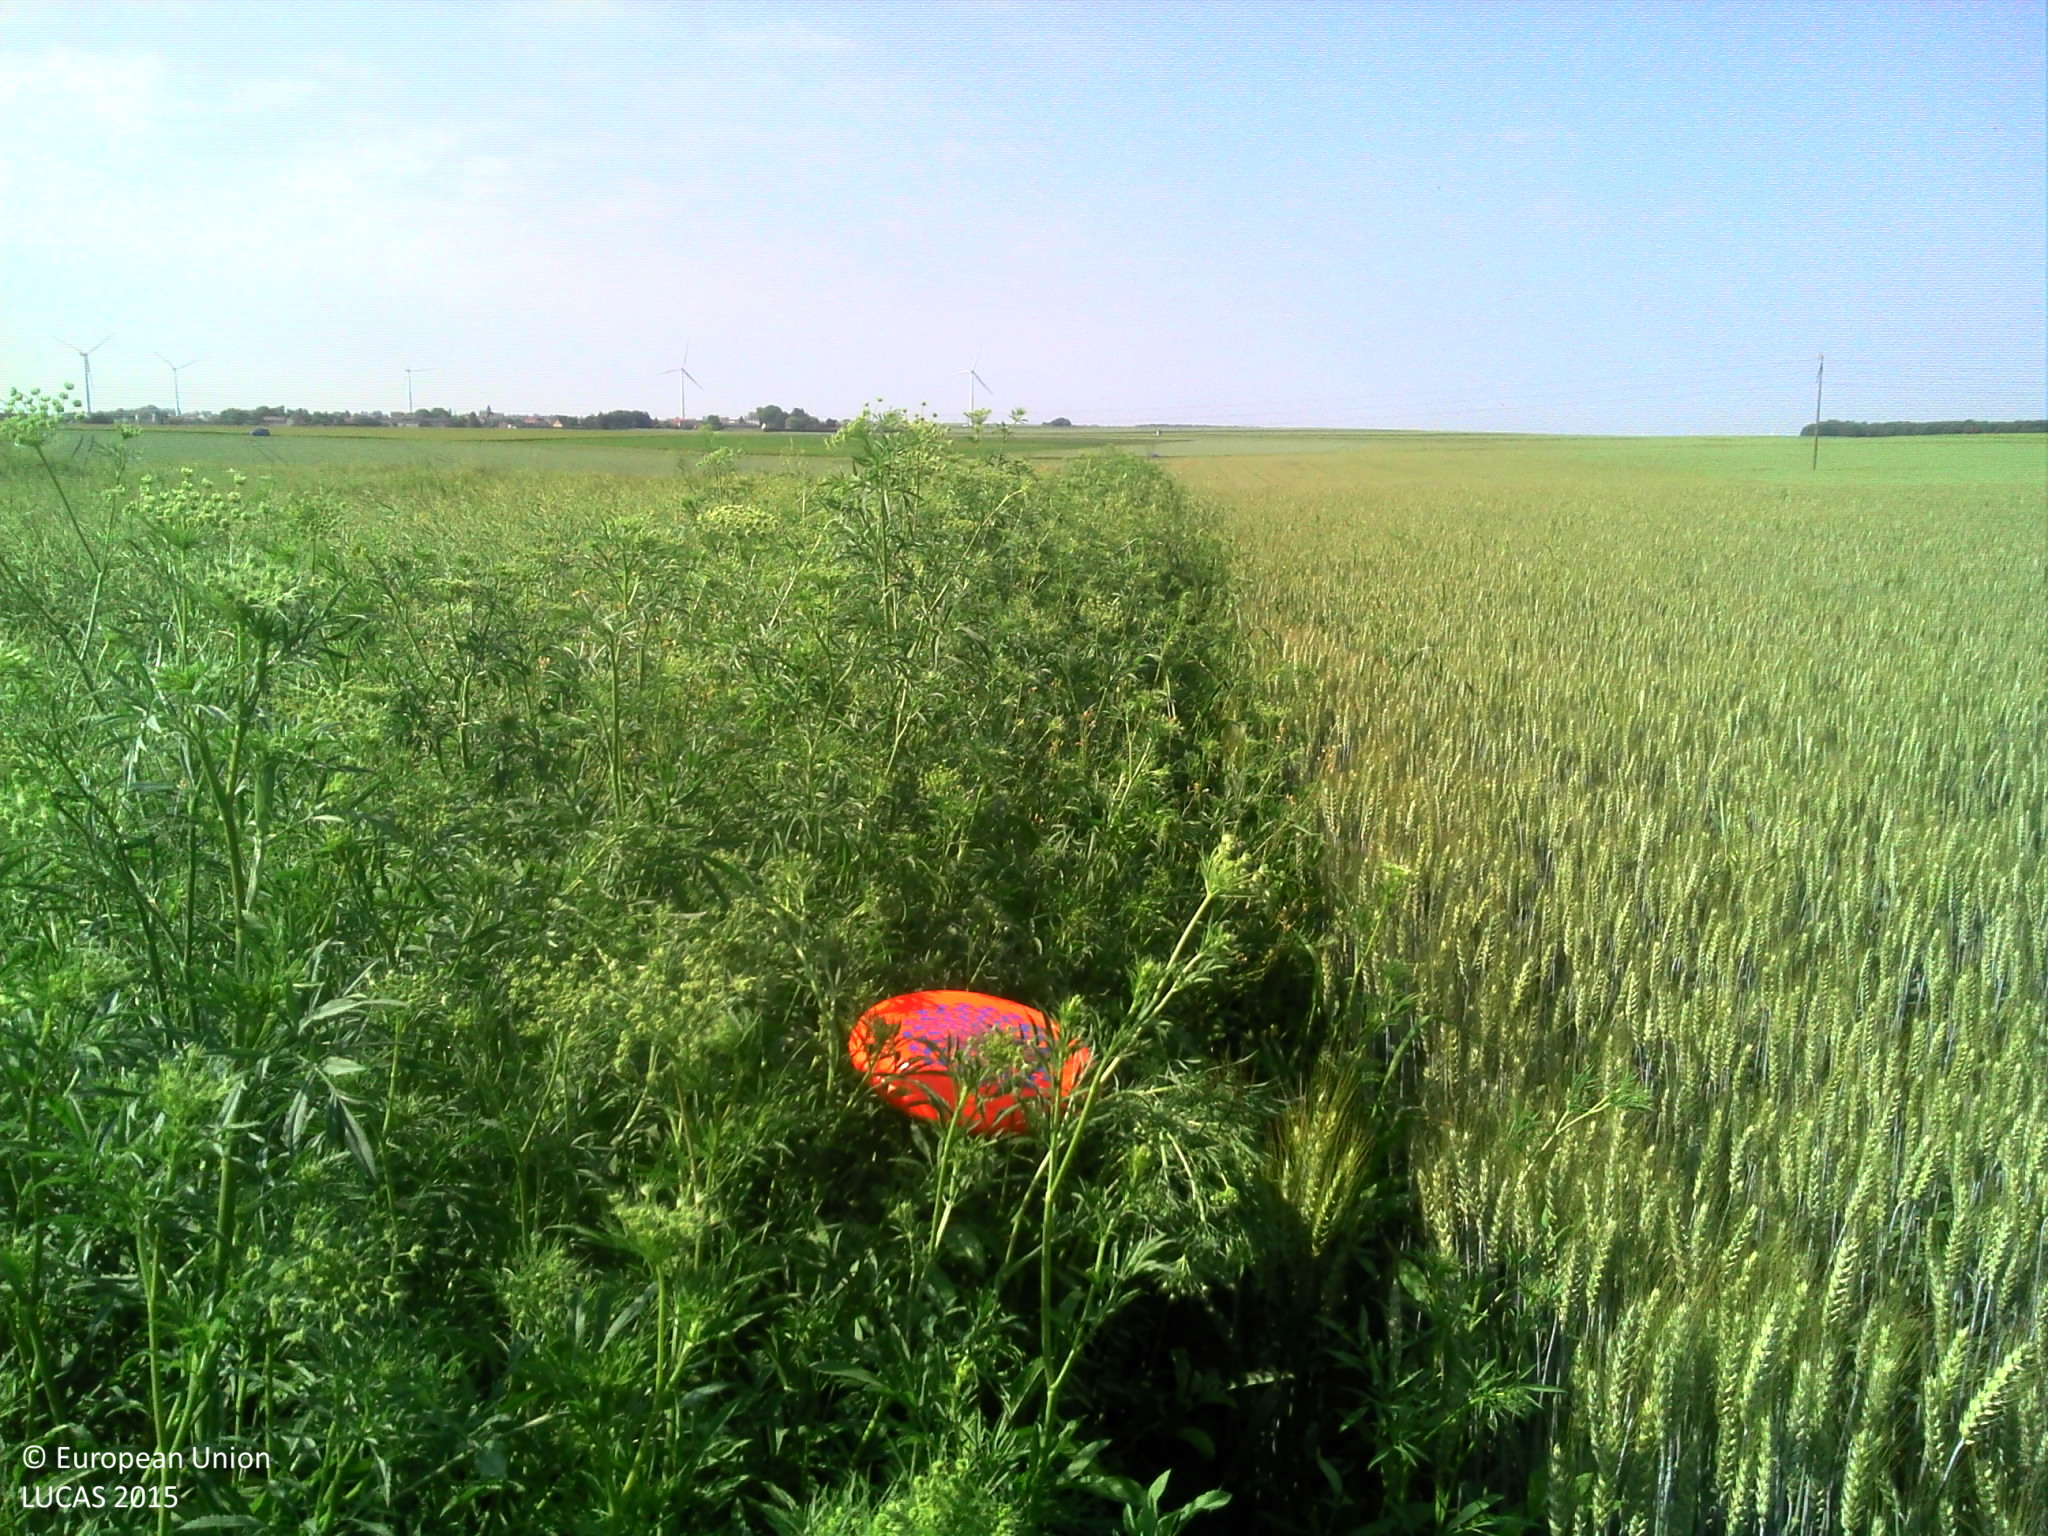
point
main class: Cropland
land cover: Common wheat
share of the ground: > 75 %
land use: Agriculture (excluding fallow land and kitchen gardens)
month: June
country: FR
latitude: 49.7495
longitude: 2.3954
